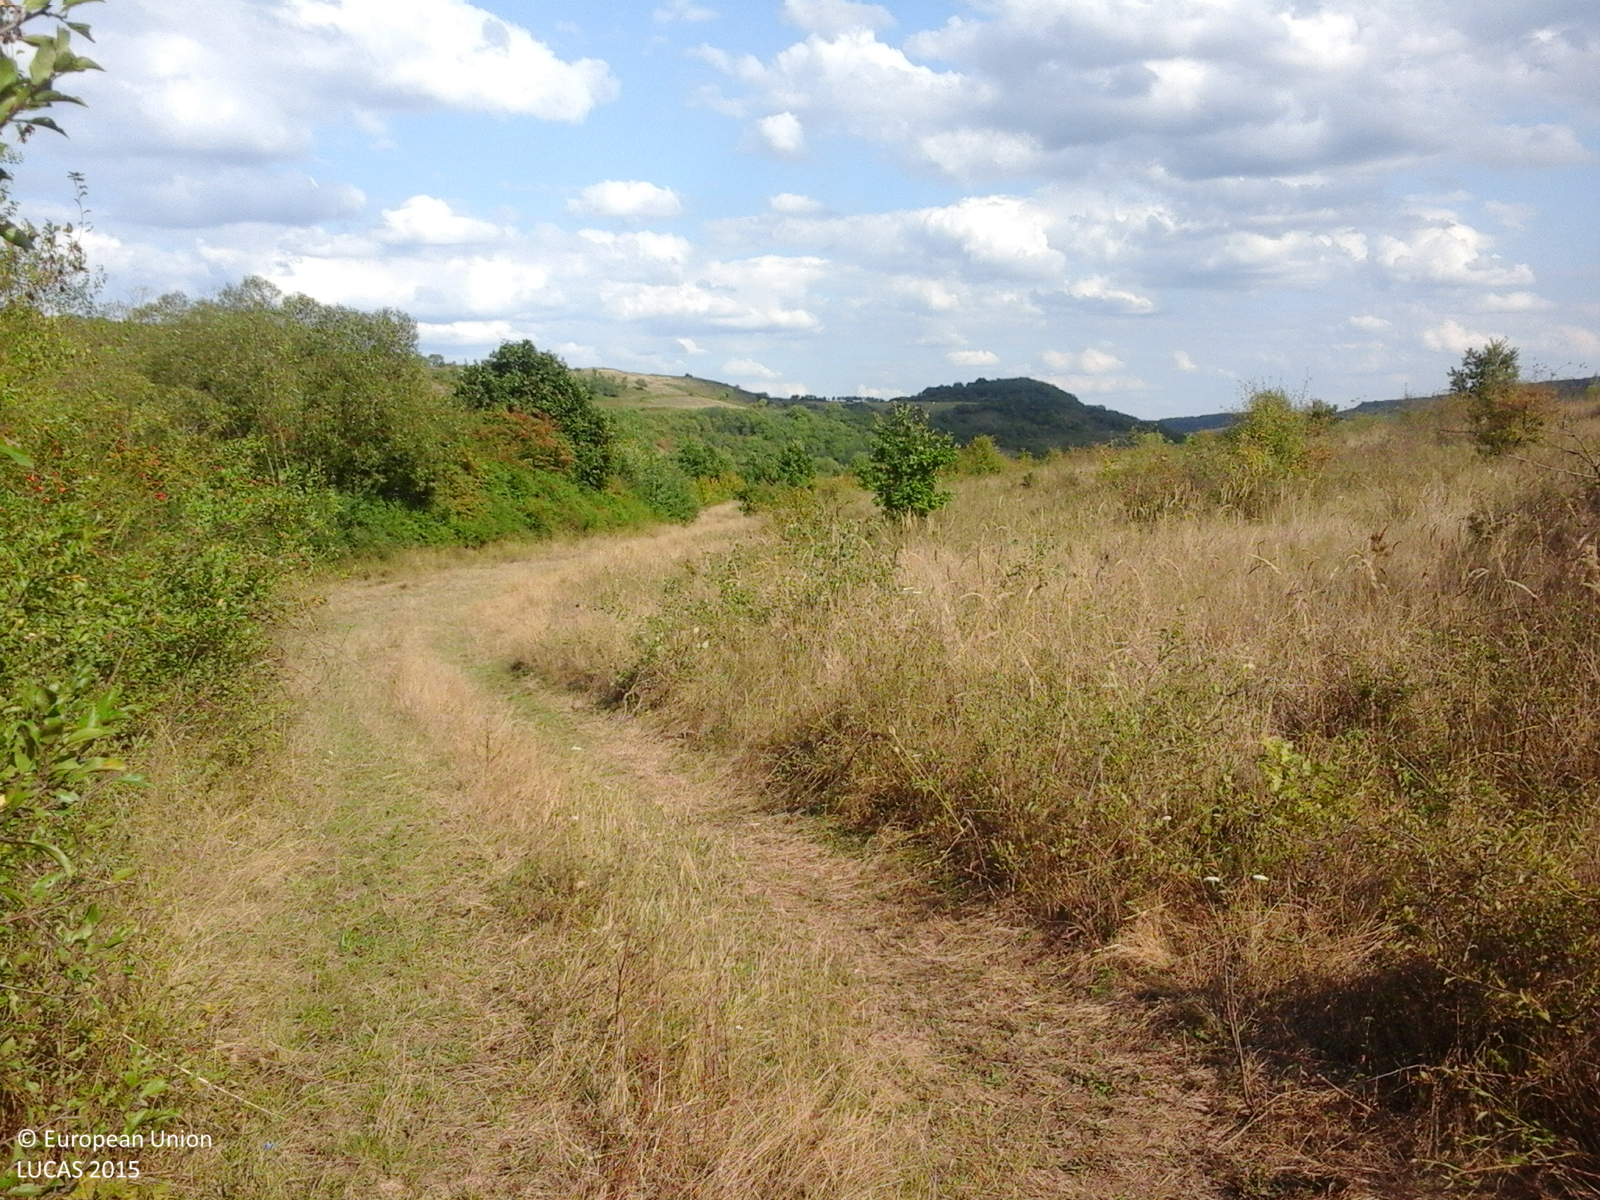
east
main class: Shrubland
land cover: Shrubland with sparse tree cover
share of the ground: > 75 %
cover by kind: shrubs 95 %, broadleaved forest trees 5 %
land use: Fallow land
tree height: > 5 m
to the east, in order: Shrubland with sparse tree cover; Grassland without tree/shrub cover; Tracks; Broadleaved woodland; Grassland with sparse tree/shrub cover; Shrubland with sparse tree cover; Grassland without tree/shrub cover
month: September
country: RO
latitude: 47.3669
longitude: 23.0825
